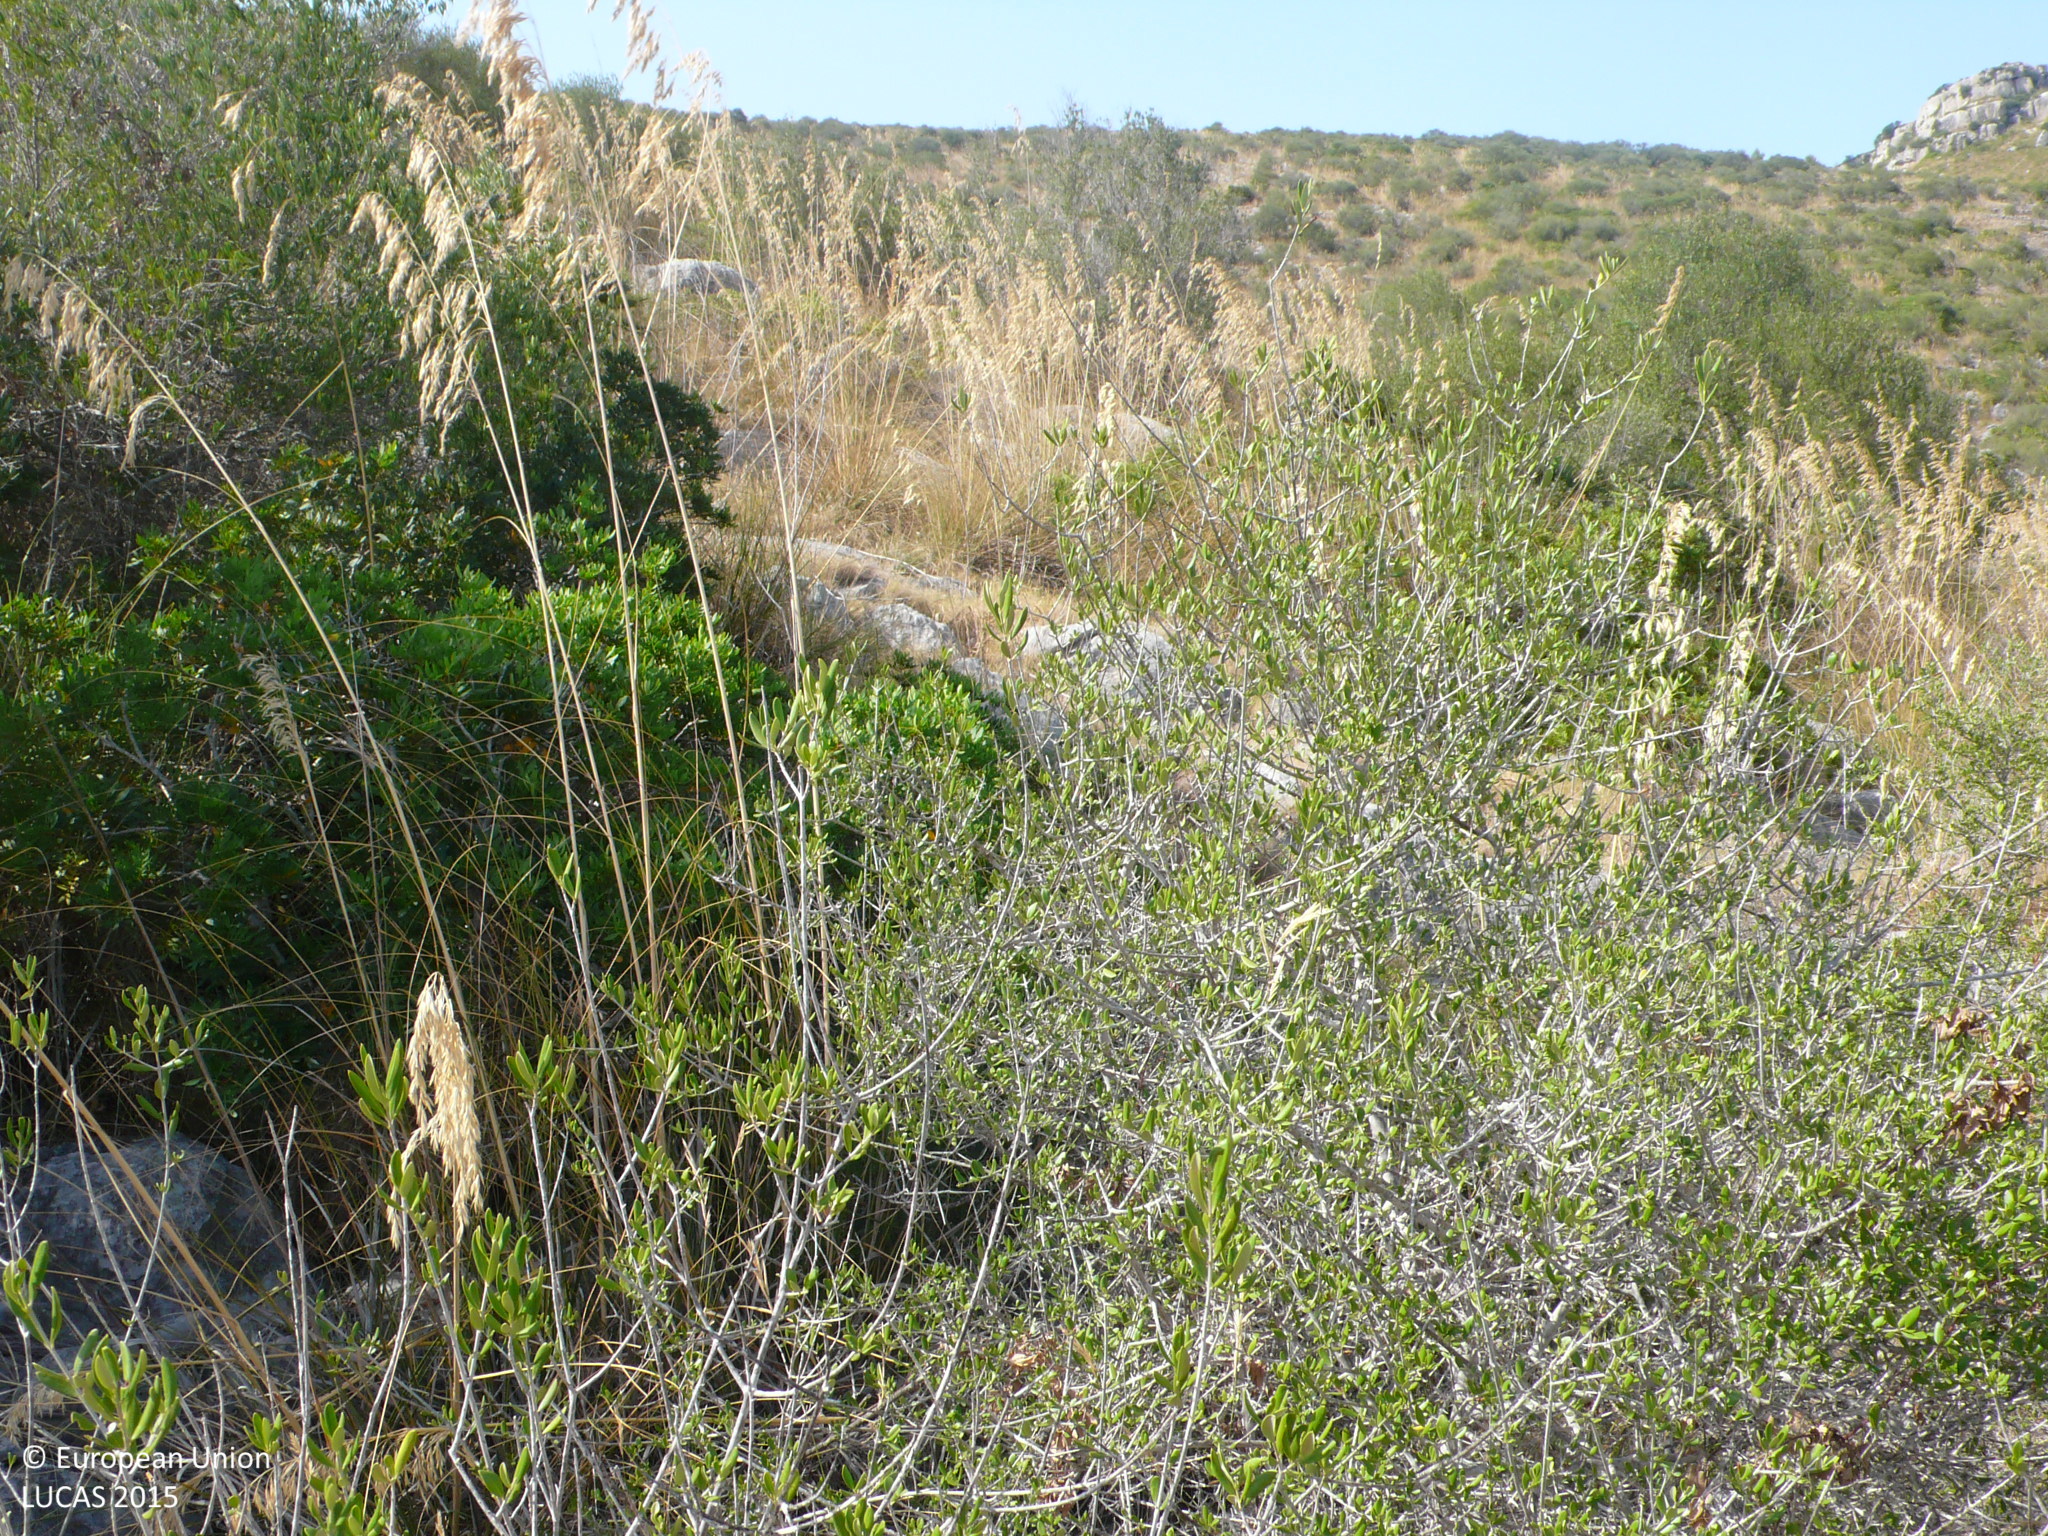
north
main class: Woodland
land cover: Broadleaved woodland
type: broadleaved evergreen forest
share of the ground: 50 - 75 %
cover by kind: broadleaved forest trees 55 %, shrubs 30 %, consolidated bare surface 15 %
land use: Semi-natural and natural areas not in use
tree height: < 5 m
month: July
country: ES
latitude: 39.6358
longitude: 3.2599
